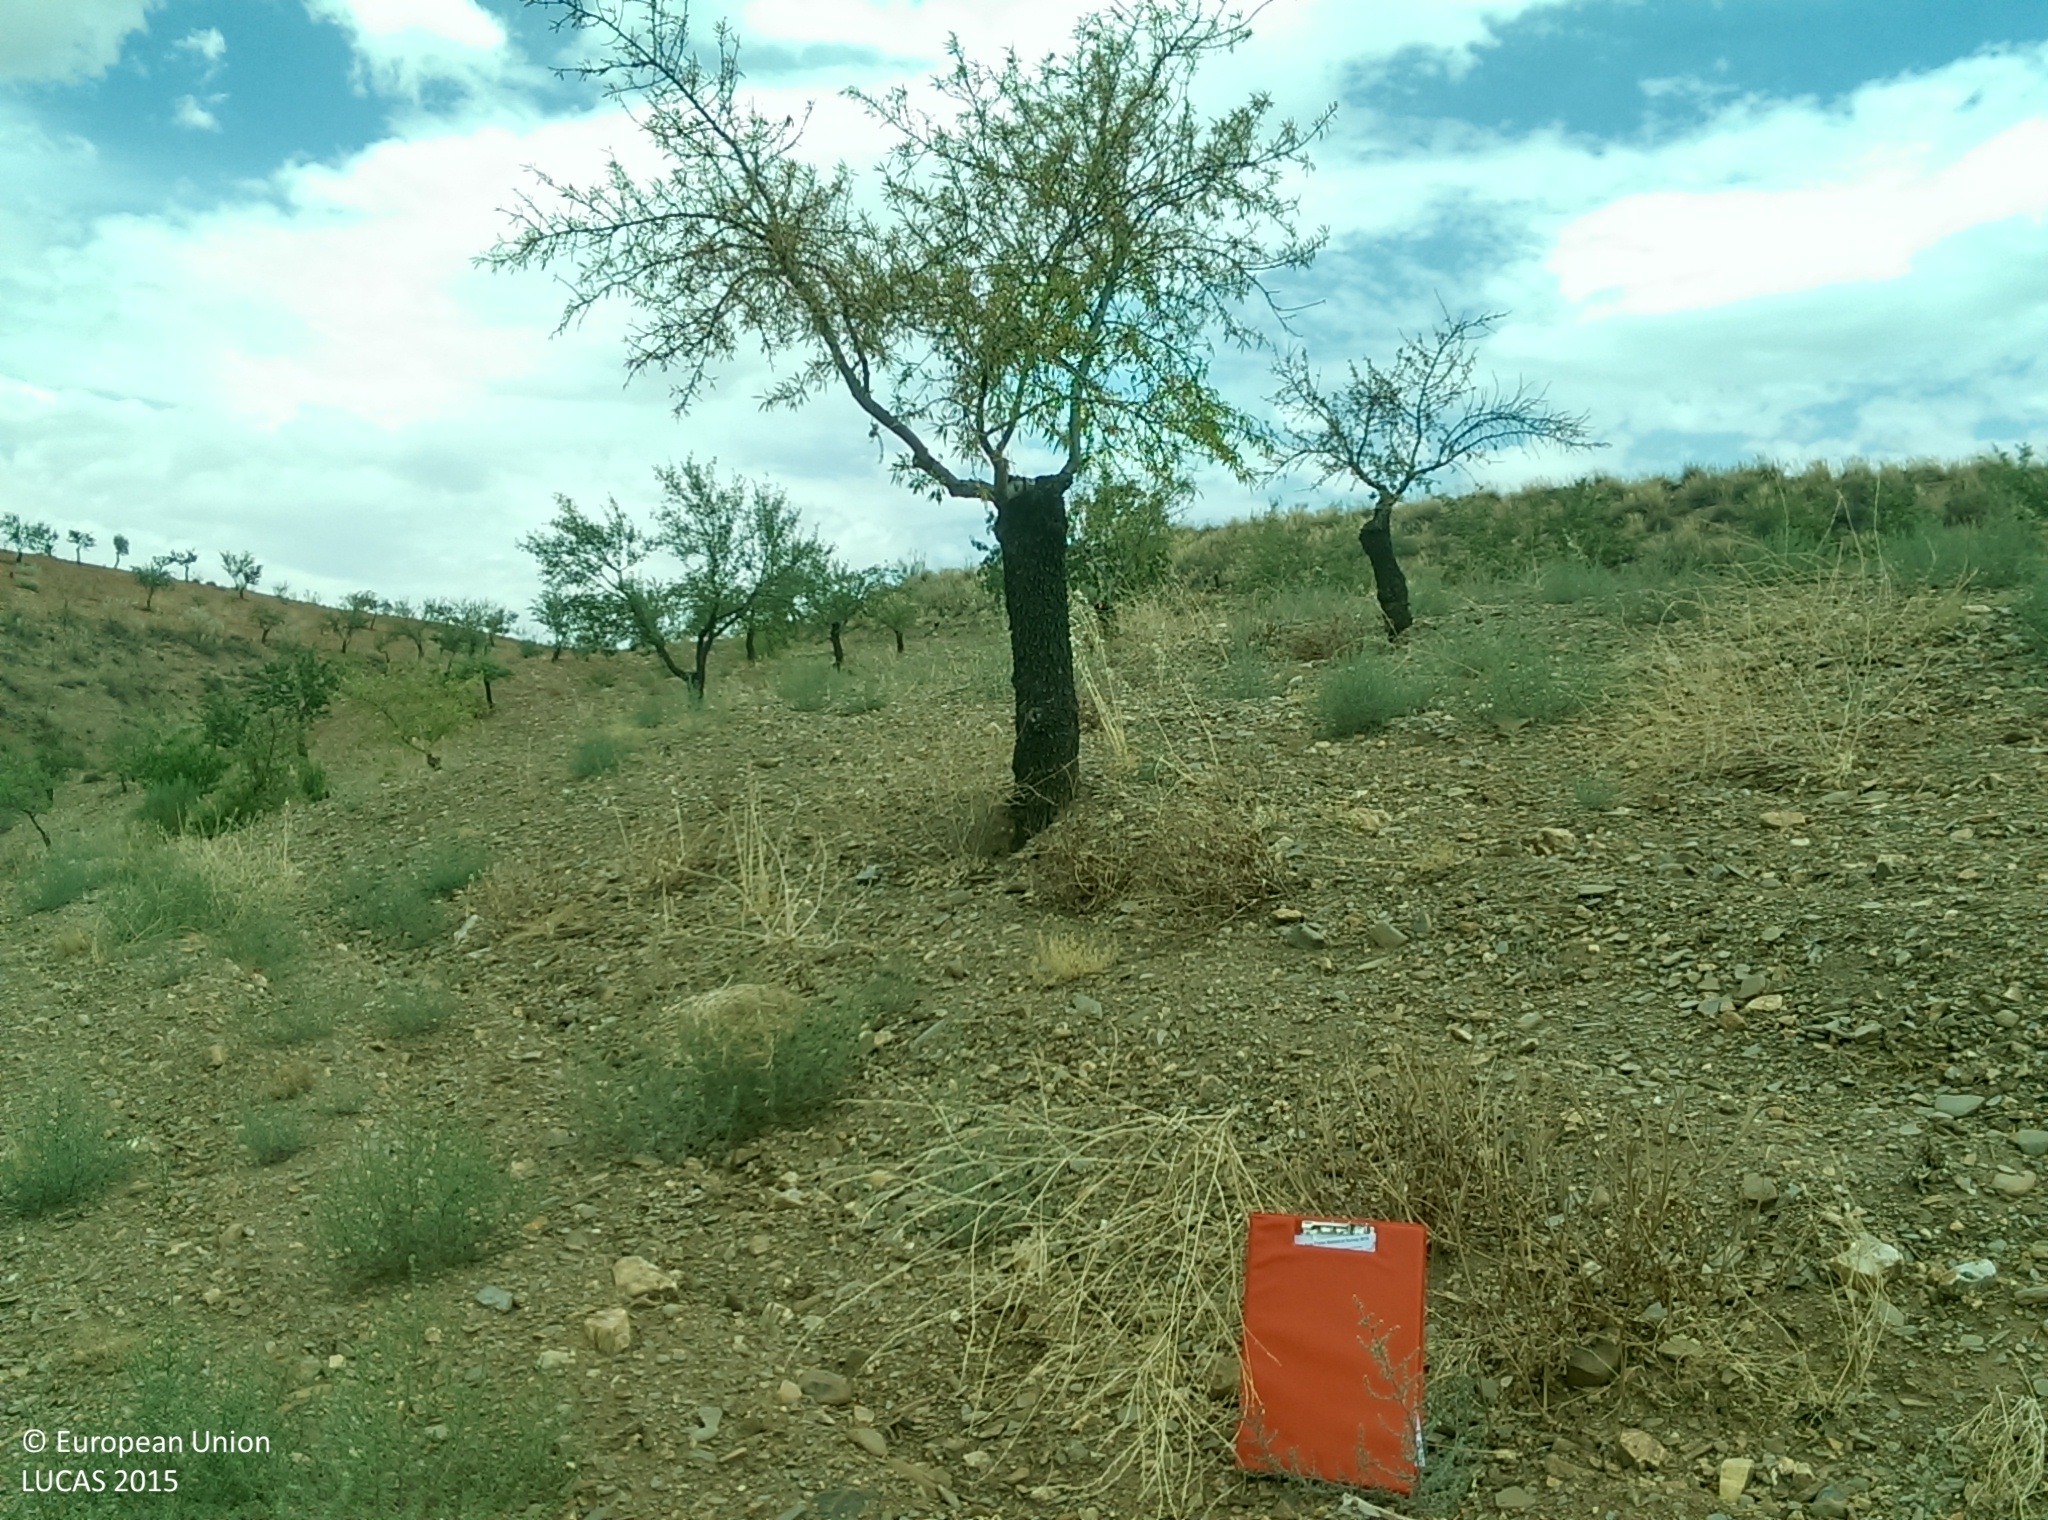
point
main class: Cropland
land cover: Nuts trees
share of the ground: < 10 %
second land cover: Spontaneously vegetated surfaces
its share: 10 - 25 %
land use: Agriculture (excluding fallow land and kitchen gardens)
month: July
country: ES
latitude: 37.1943
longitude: -2.9054
